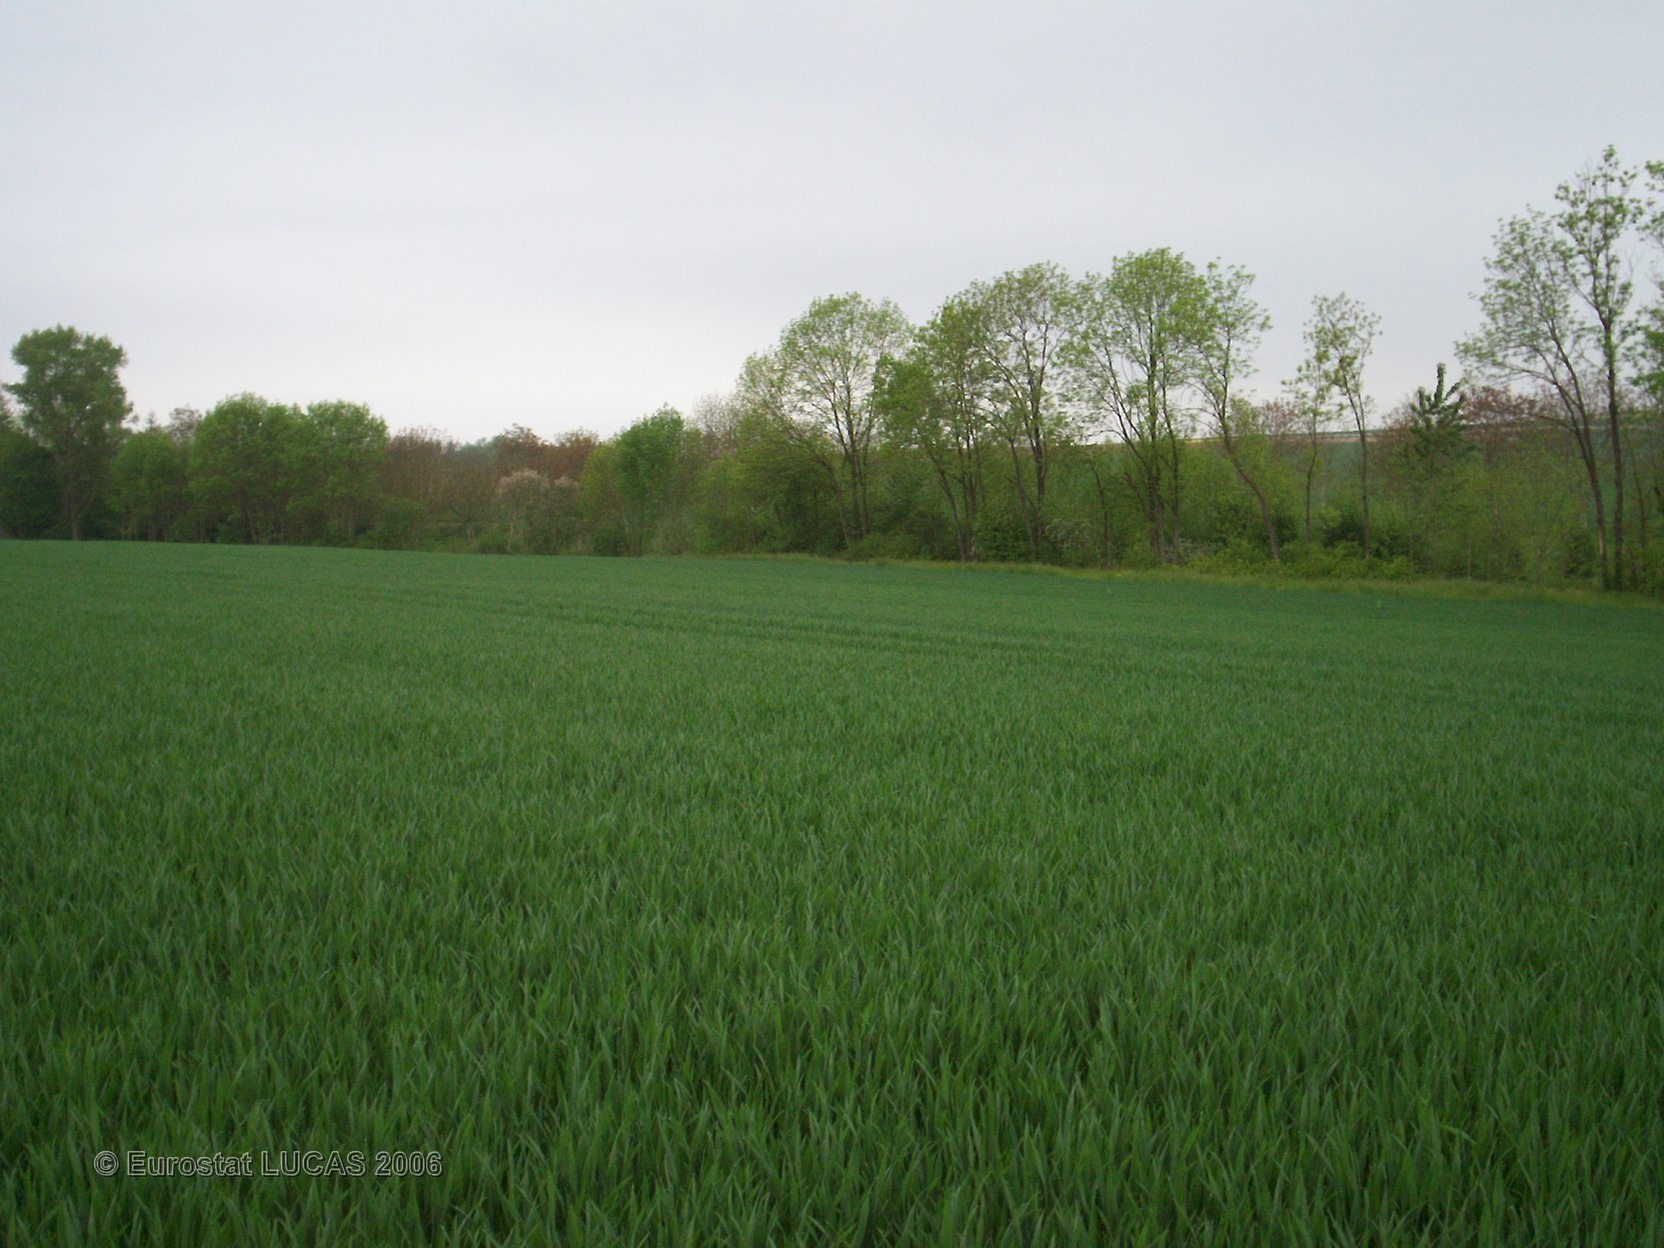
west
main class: Cropland
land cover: Common wheat
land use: Agriculture (excluding fallow land and kitchen gardens)
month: May
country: FR
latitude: 49.5212
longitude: 4.3459
